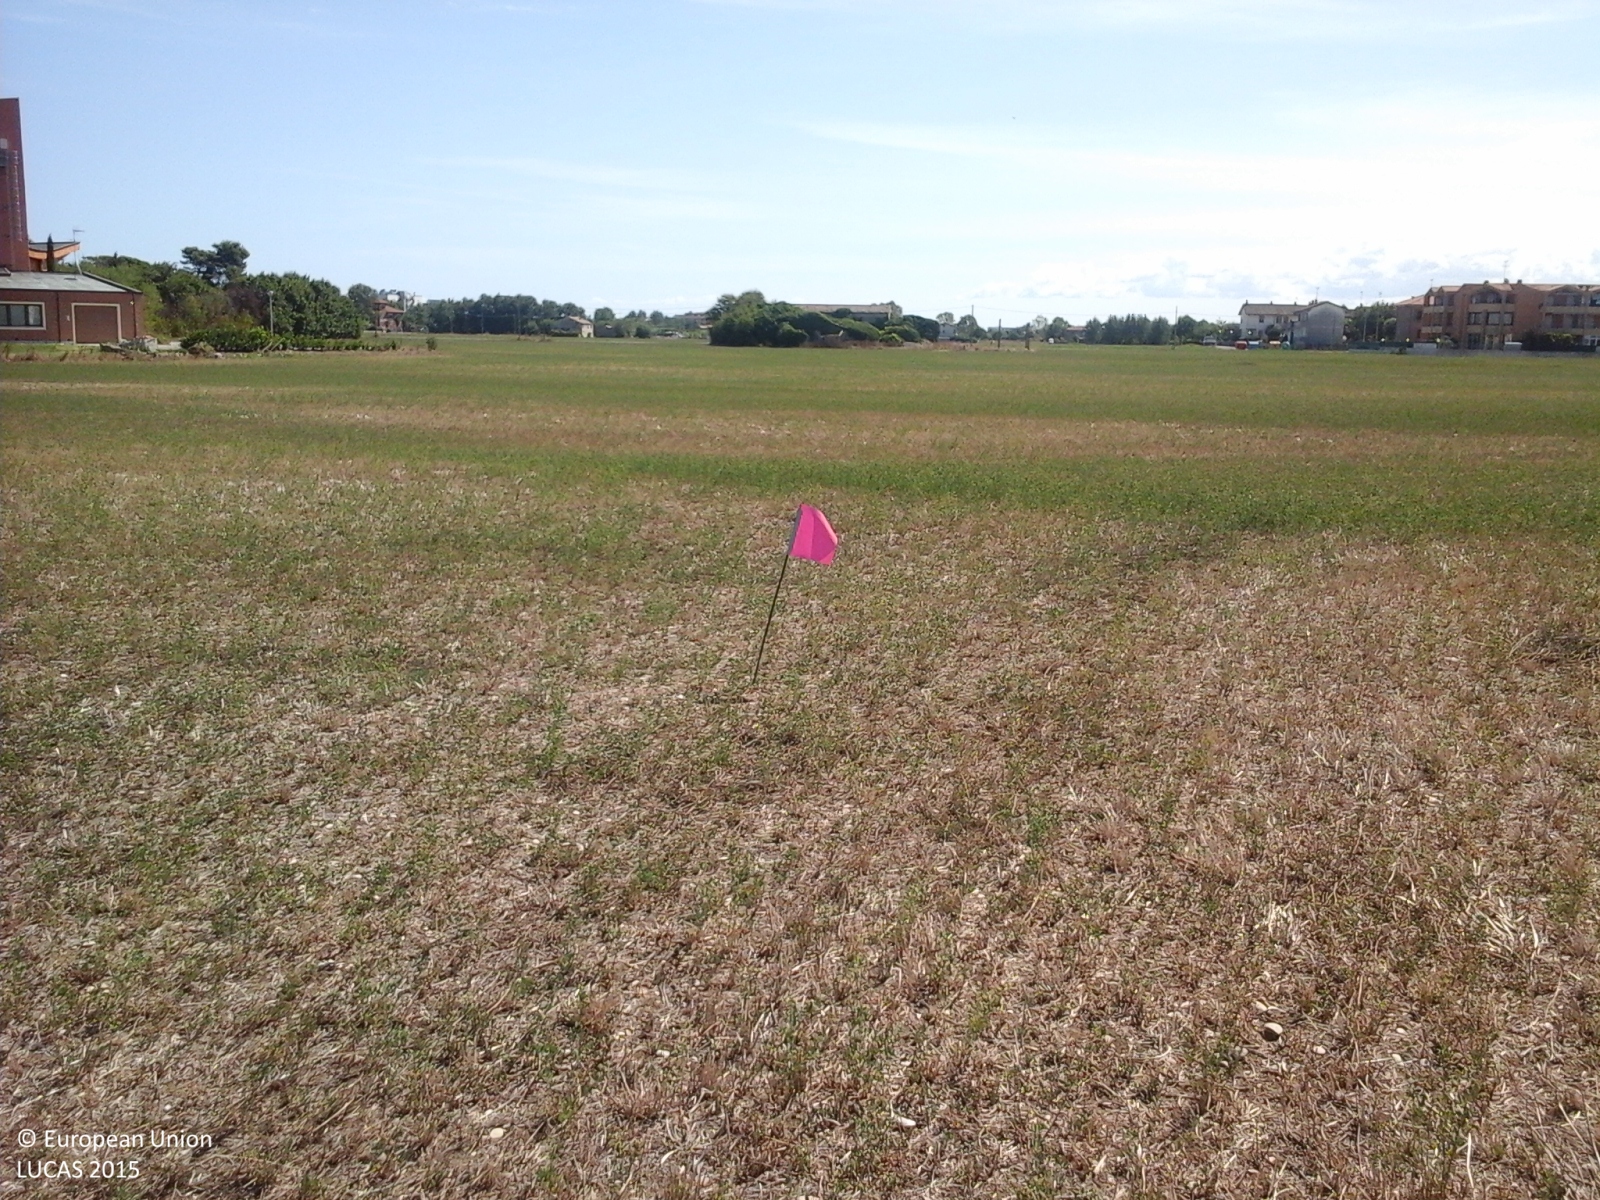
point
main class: Cropland
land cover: Lucerne
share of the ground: > 75 %
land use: Agriculture (excluding fallow land and kitchen gardens)
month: September
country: IT
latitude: 43.7992
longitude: 13.0876
